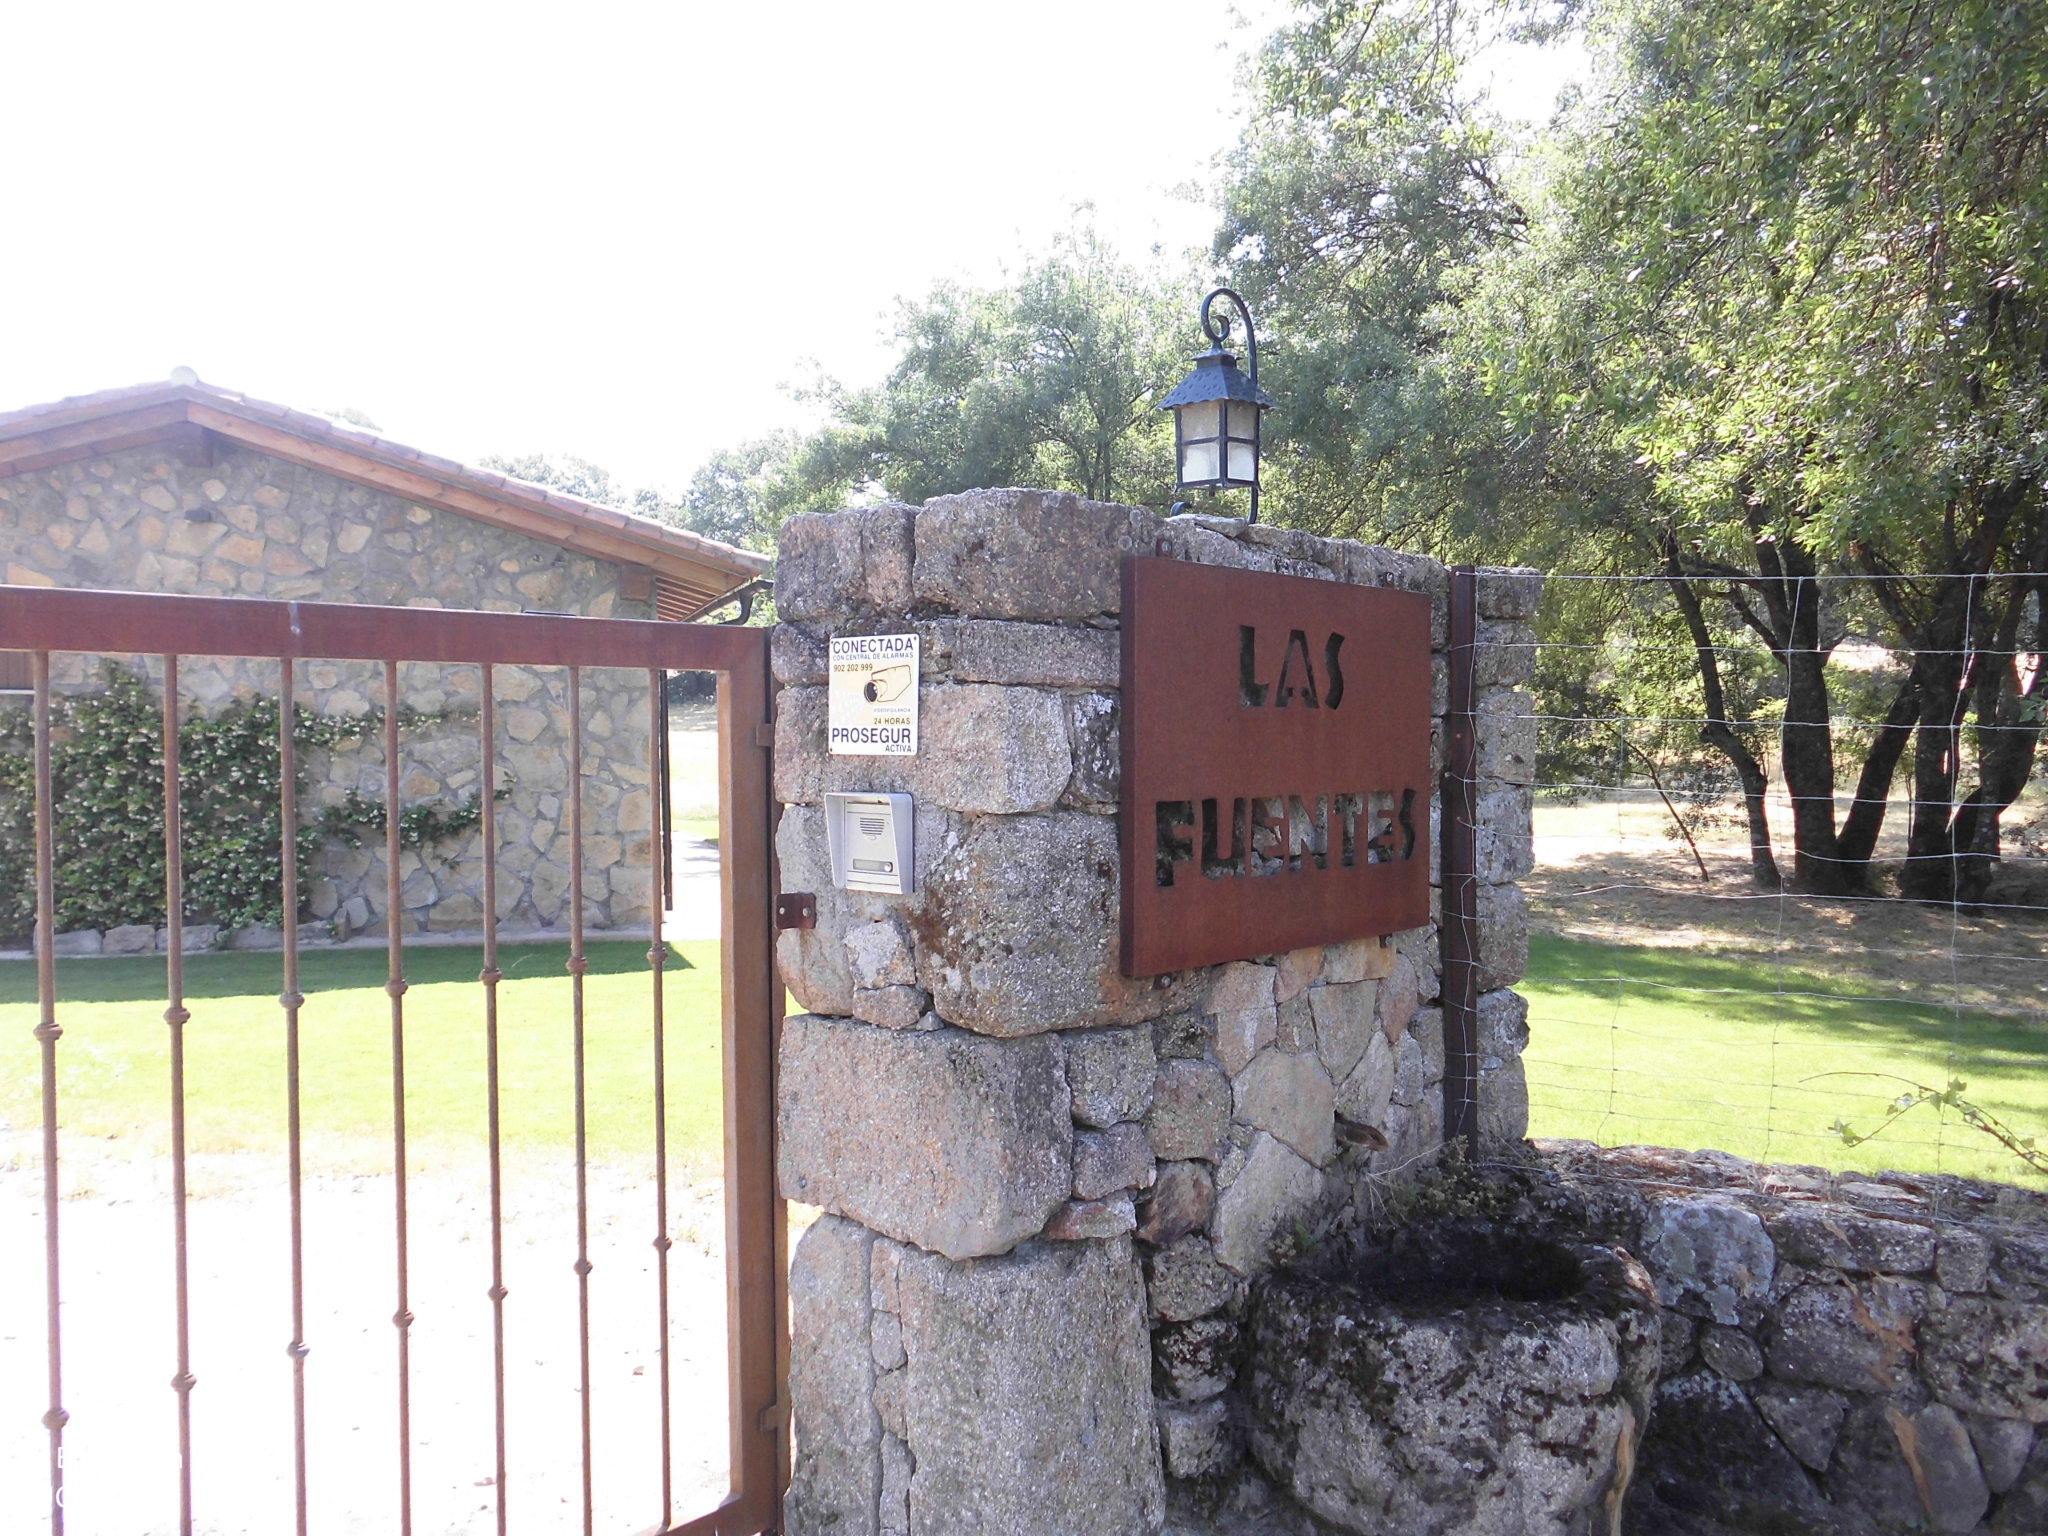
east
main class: Shrubland
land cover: Shrubland with sparse tree cover
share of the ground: 25 - 50 %
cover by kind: herbaceous plants 50 %, shrubs 45 %, broadleaved forest trees 5 %
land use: Agriculture (excluding fallow land and kitchen gardens)
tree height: > 5 m
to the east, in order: Shrubland with sparse tree cover; Fences; Shrubland with sparse tree cover
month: June
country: ES
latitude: 40.1029
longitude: -5.4395
